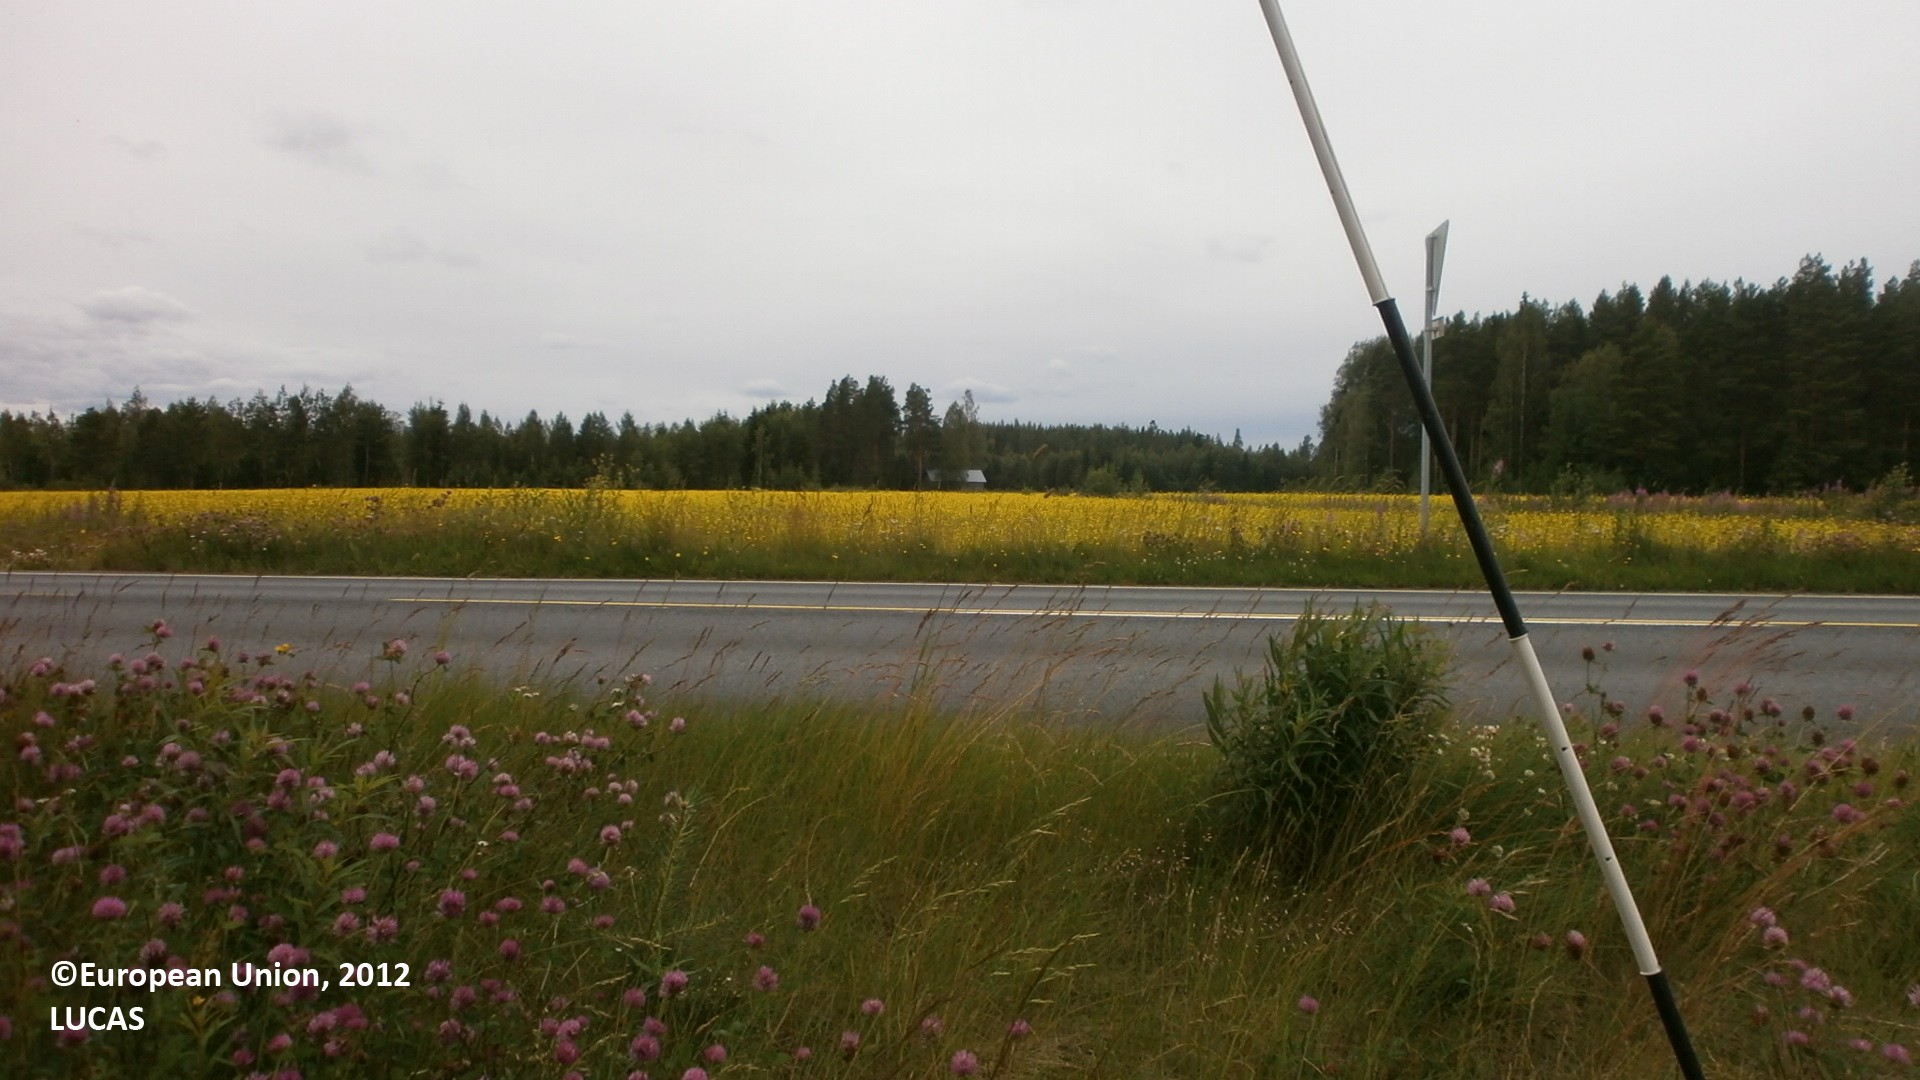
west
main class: Grassland
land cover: Spontaneously vegetated surfaces
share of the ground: > 75 %
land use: Road transport
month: July
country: FI
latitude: 63.9878
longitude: 24.2742
